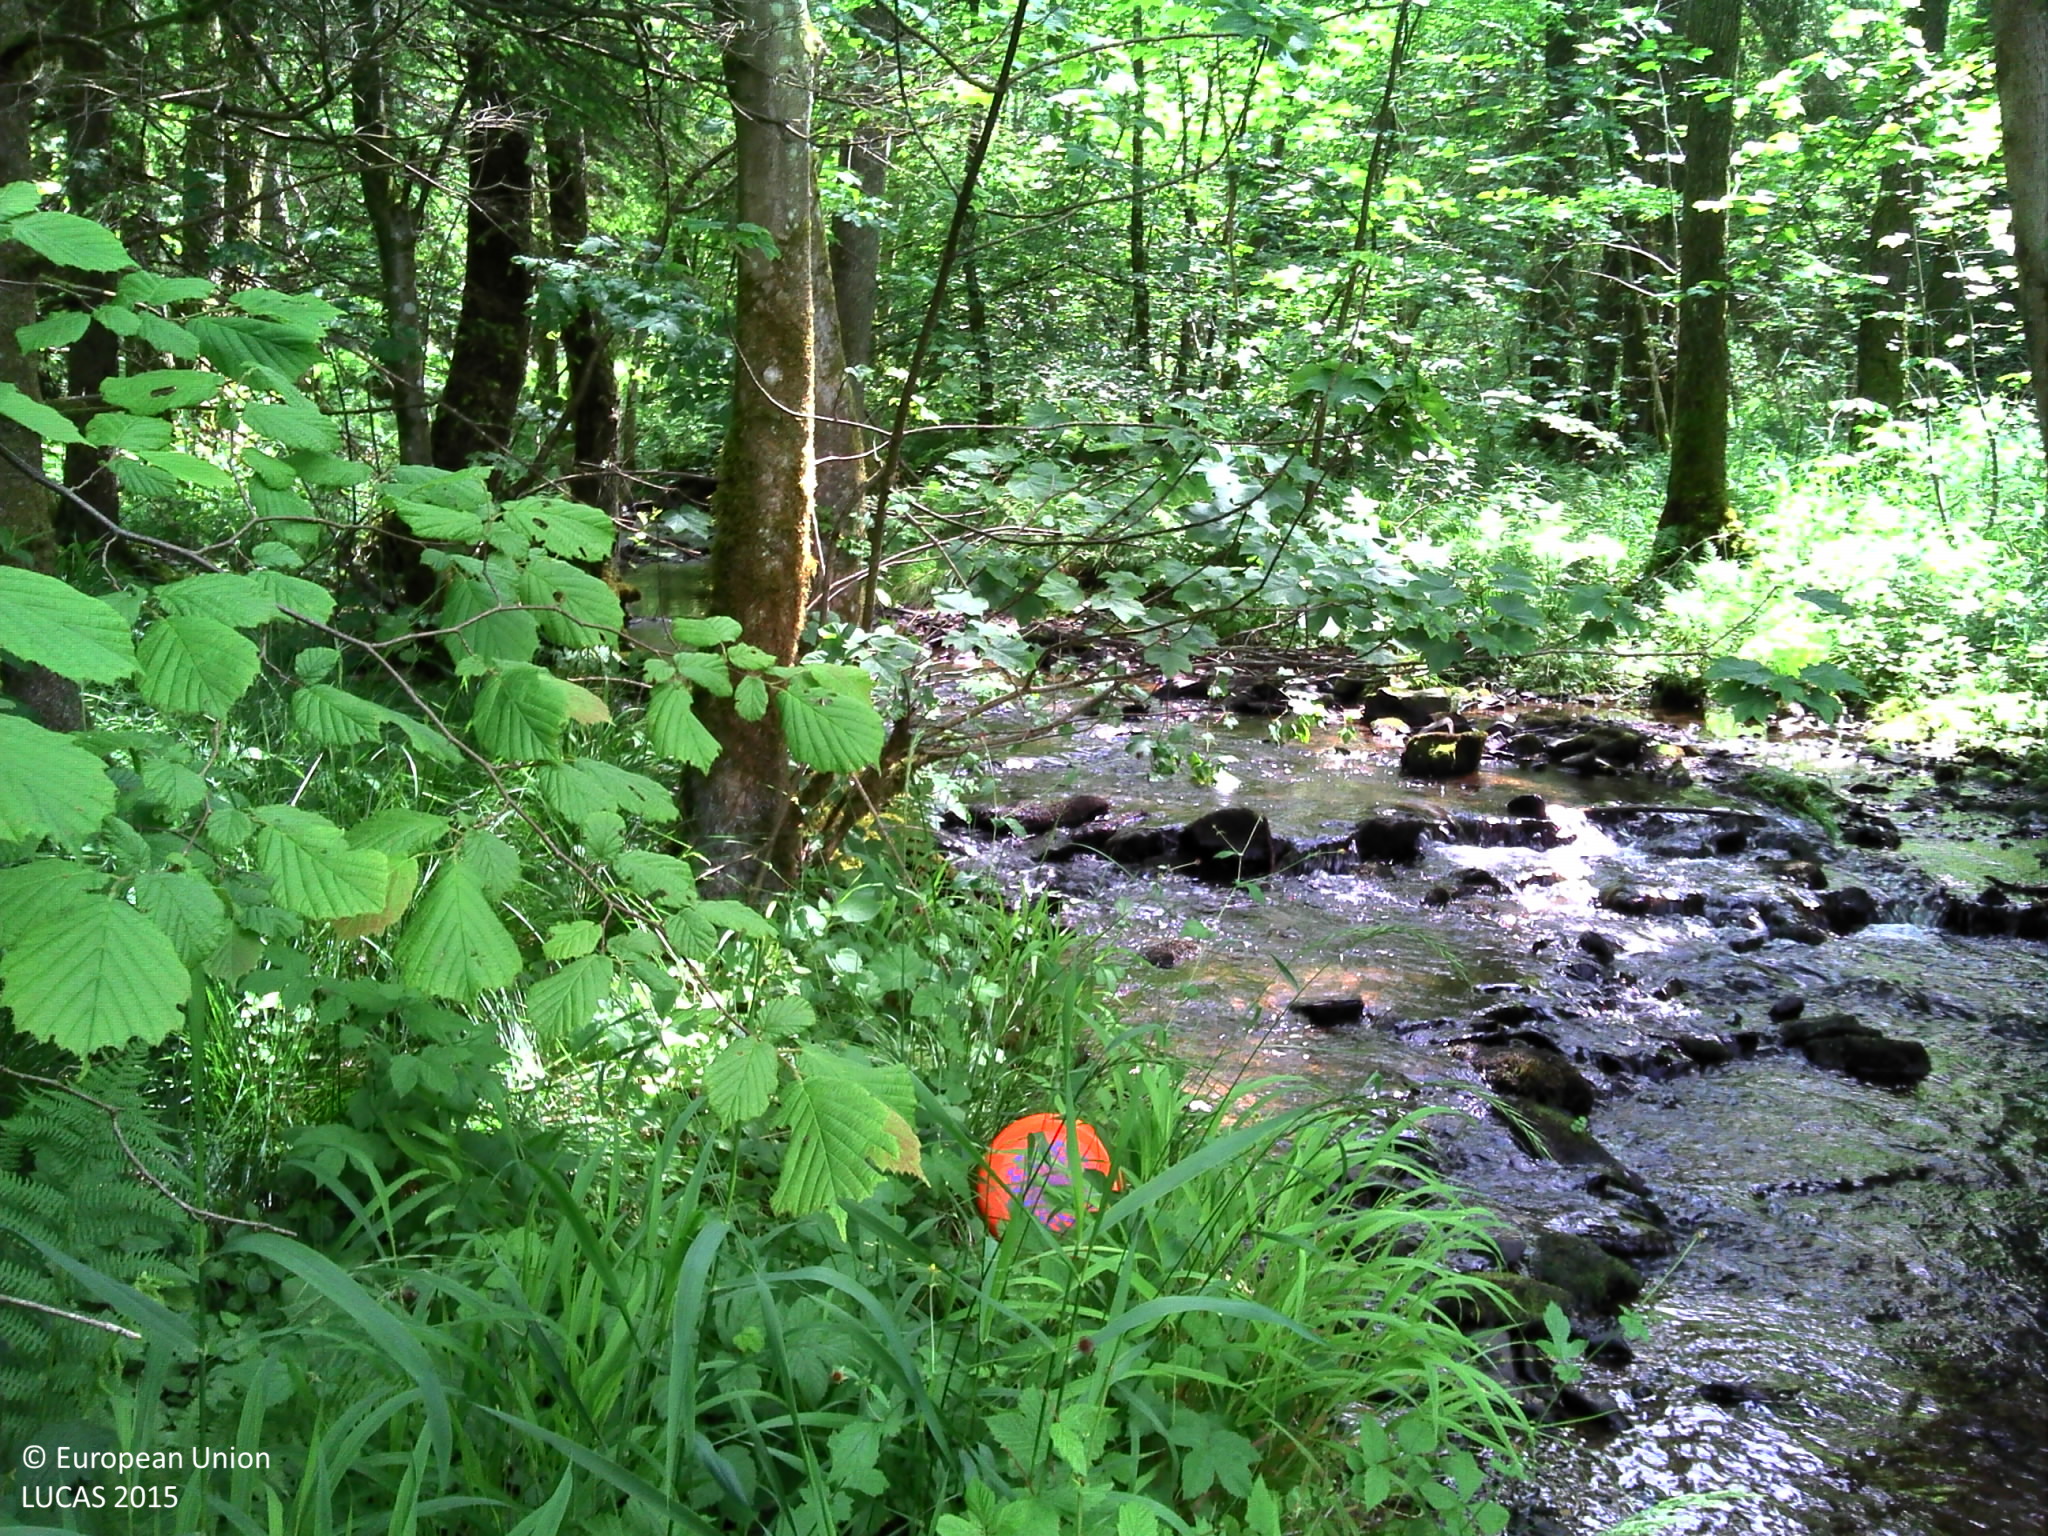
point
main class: Woodland
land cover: Broadleaved woodland
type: floodplain forest
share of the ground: > 75 %
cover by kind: broadleaved forest trees 85 %, coniferous forest trees 10 %, herbaceous plants 5 %
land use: Forestry
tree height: > 5 m
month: June
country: BE
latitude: 50.2438
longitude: 5.6094
